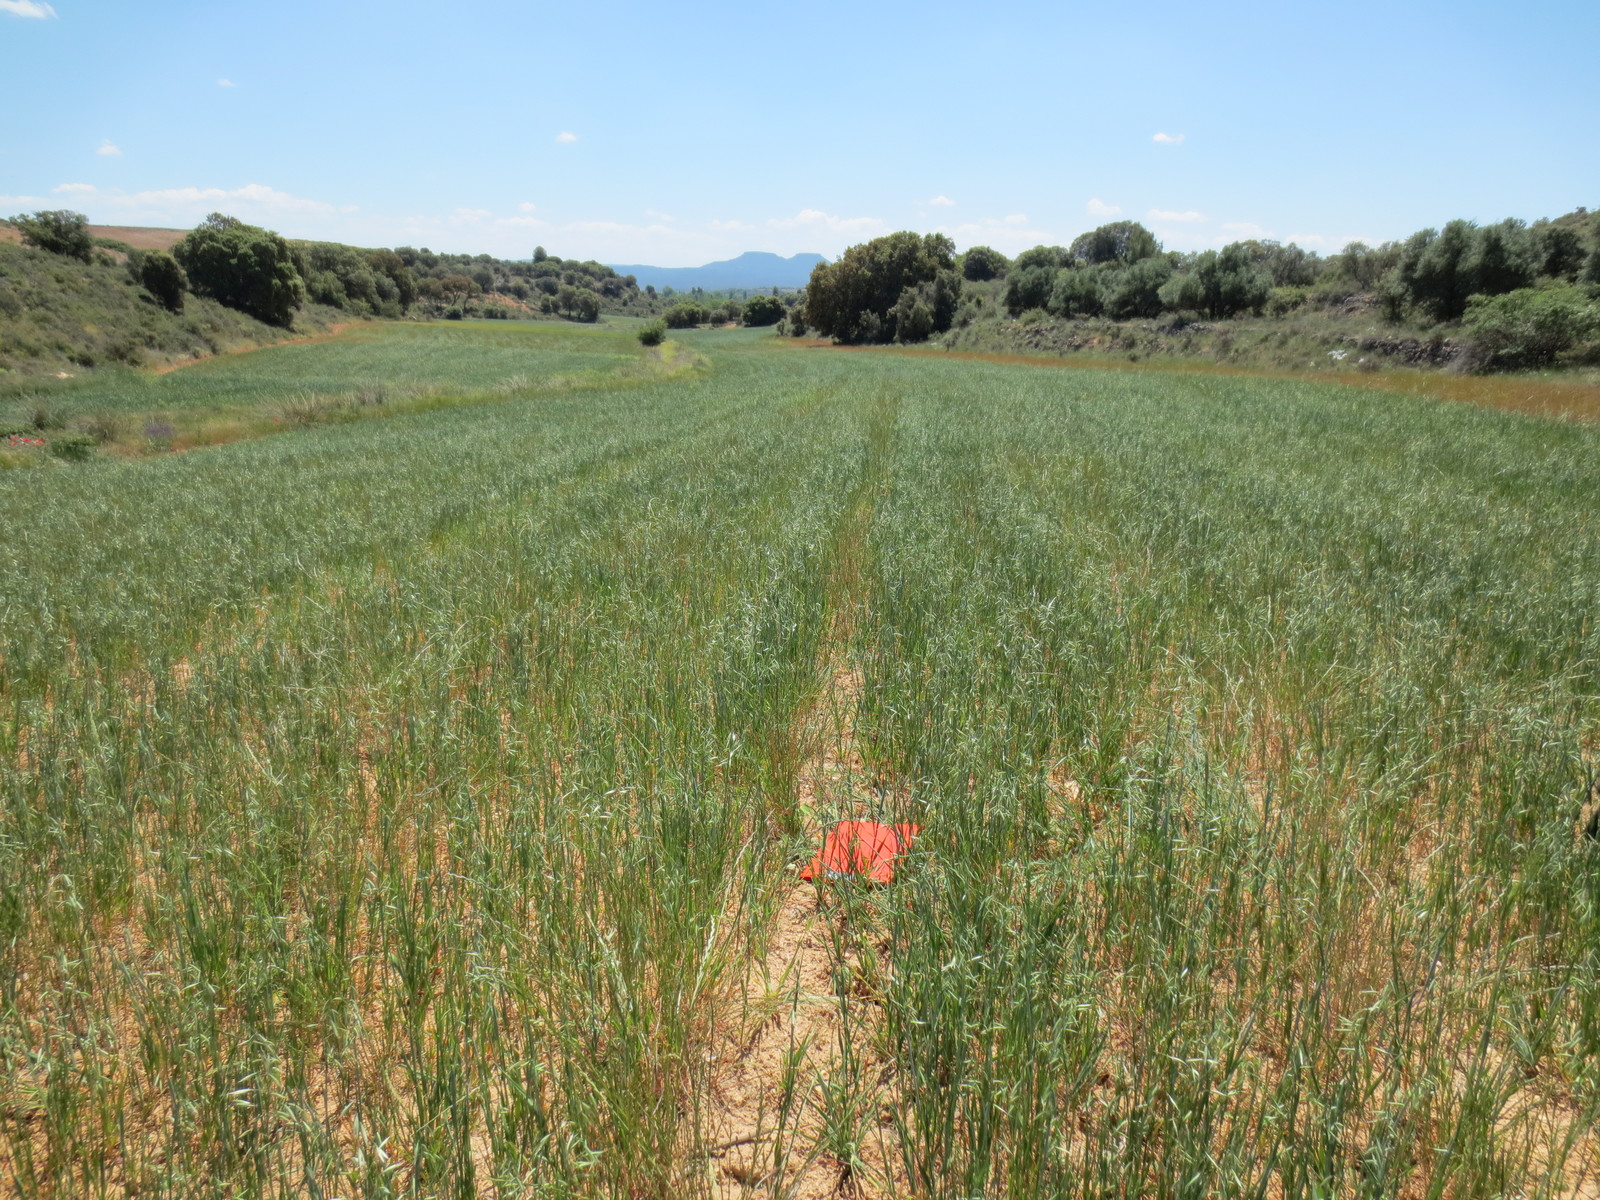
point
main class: Cropland
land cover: Oats
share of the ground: > 75 %
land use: Agriculture (excluding fallow land and kitchen gardens)
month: May
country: ES
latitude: 40.7442
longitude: -2.6413
